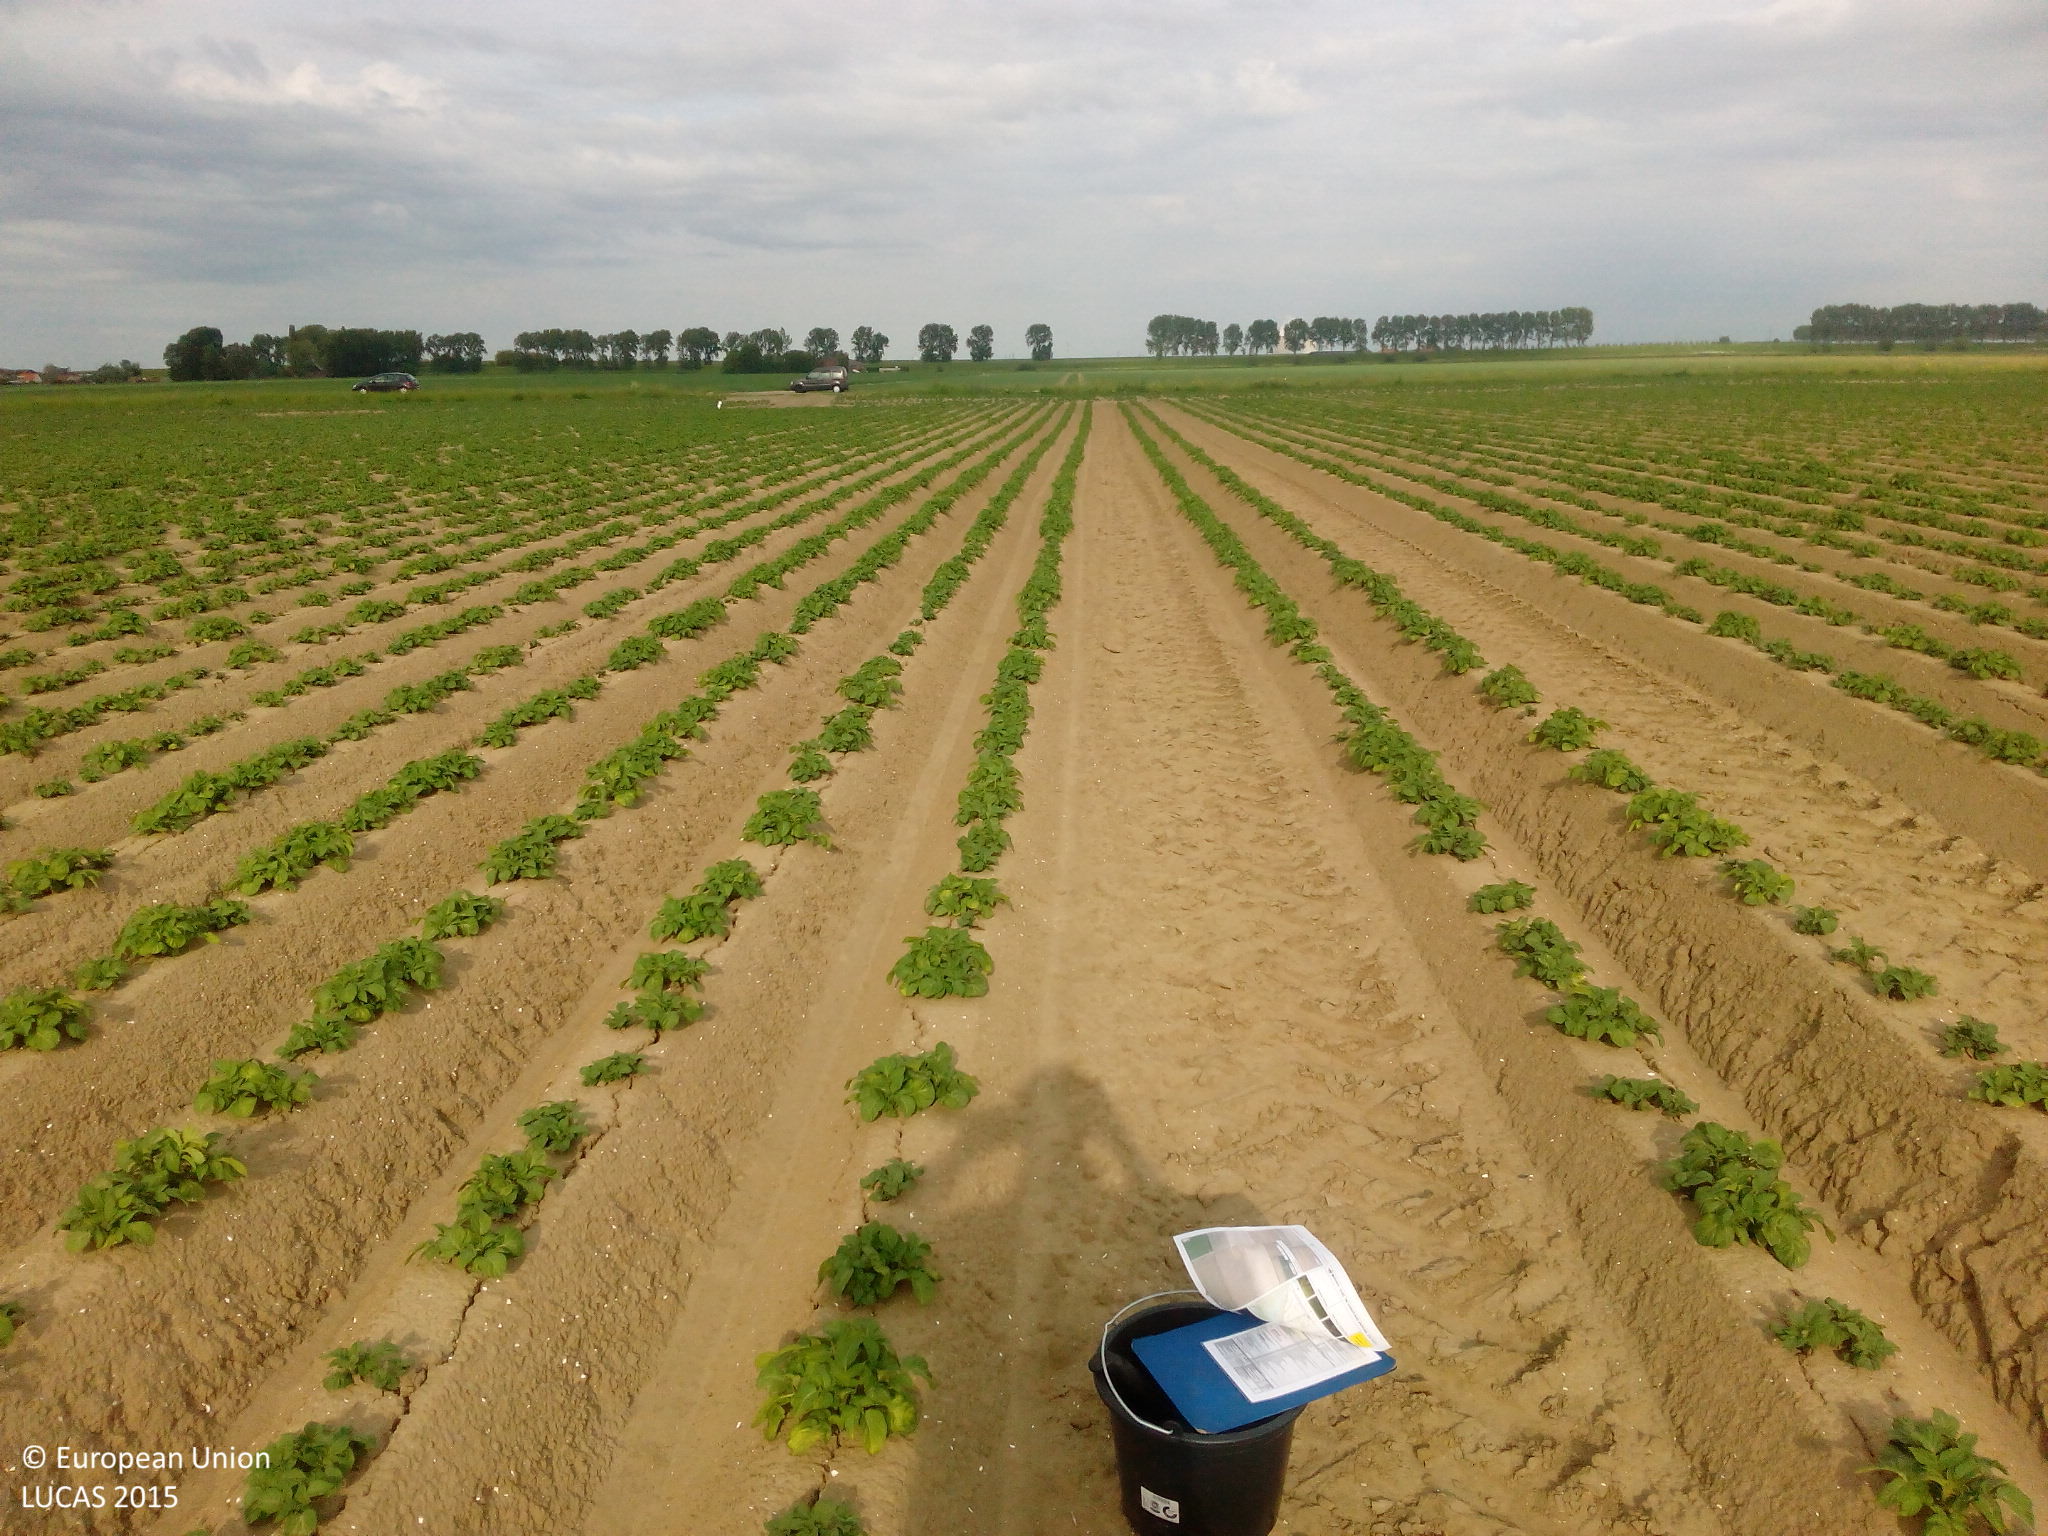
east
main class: Cropland
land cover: Potatoes
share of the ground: < 10 %
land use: Agriculture (excluding fallow land and kitchen gardens)
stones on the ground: < 10 %
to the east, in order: Potatoes; Ditches and canals; Grass margins; Paved roads, cycling and walking lanes; Grass margins; Other root crops; Tracks
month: May
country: NL
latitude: 51.3472
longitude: 4.0936
